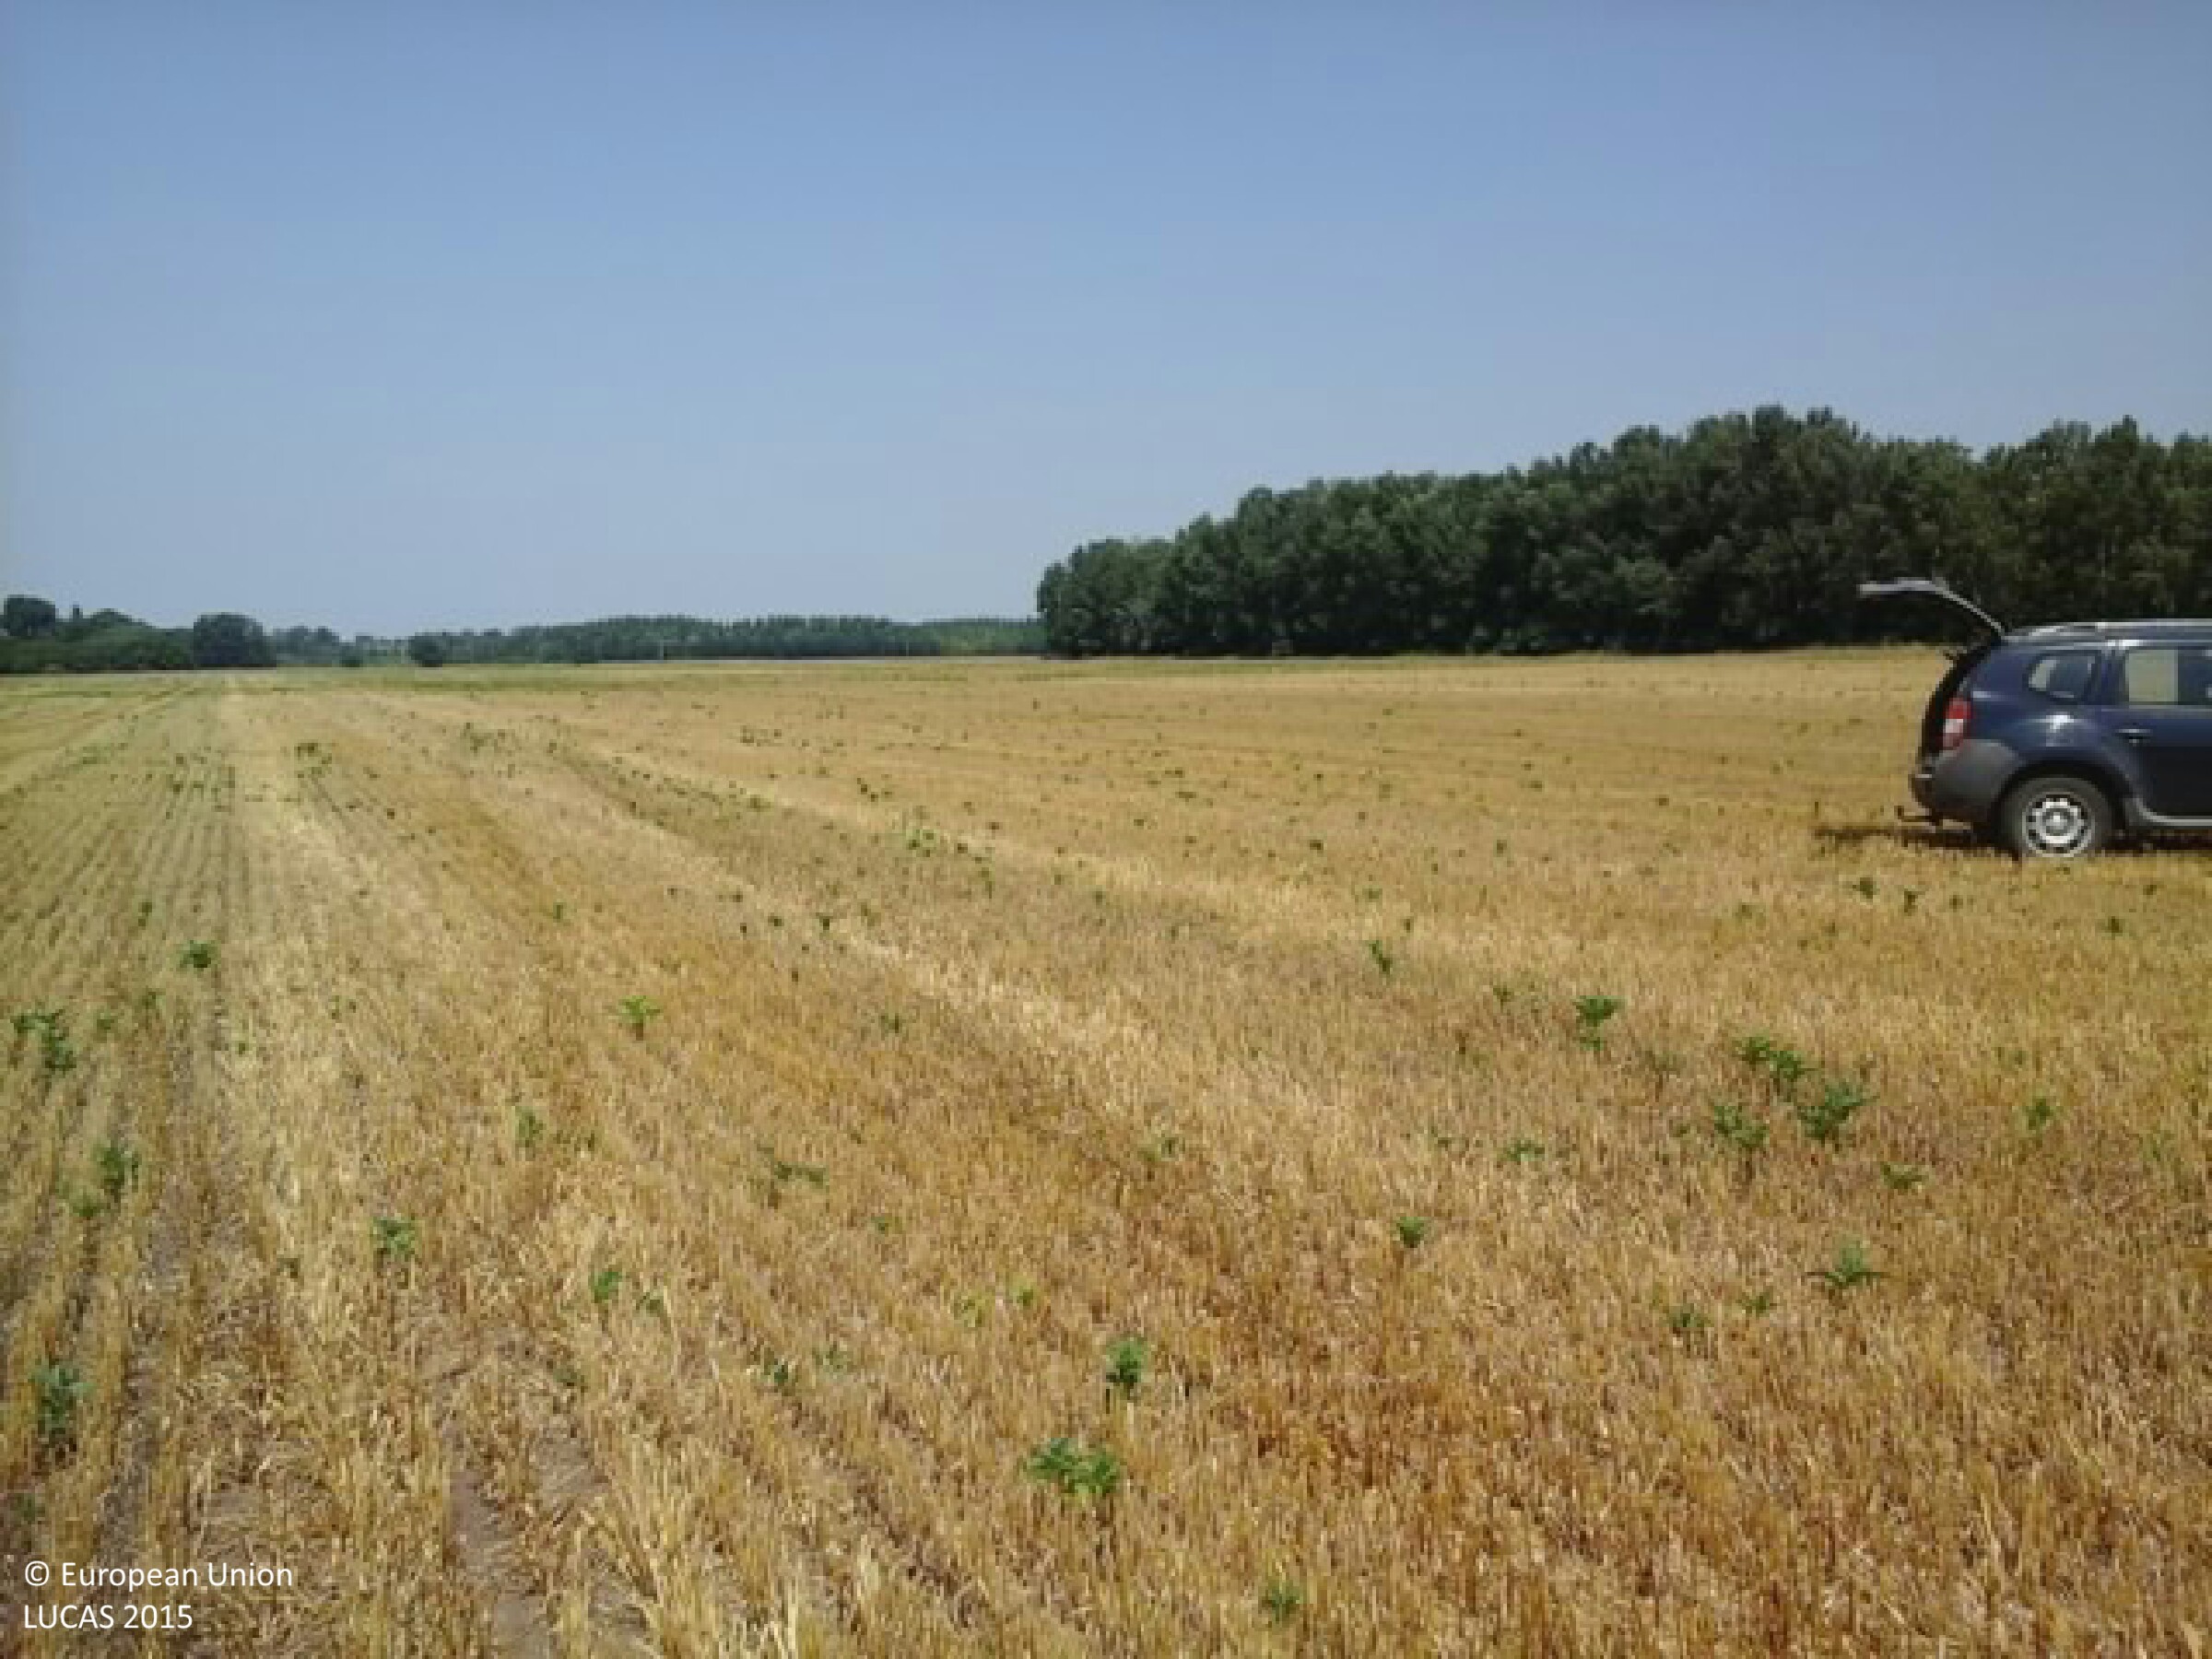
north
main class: Cropland
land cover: Barley
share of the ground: 25 - 50 %
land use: Agriculture (excluding fallow land and kitchen gardens)
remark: Harvested field
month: July
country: HU
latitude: 46.0778
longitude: 19.4415
